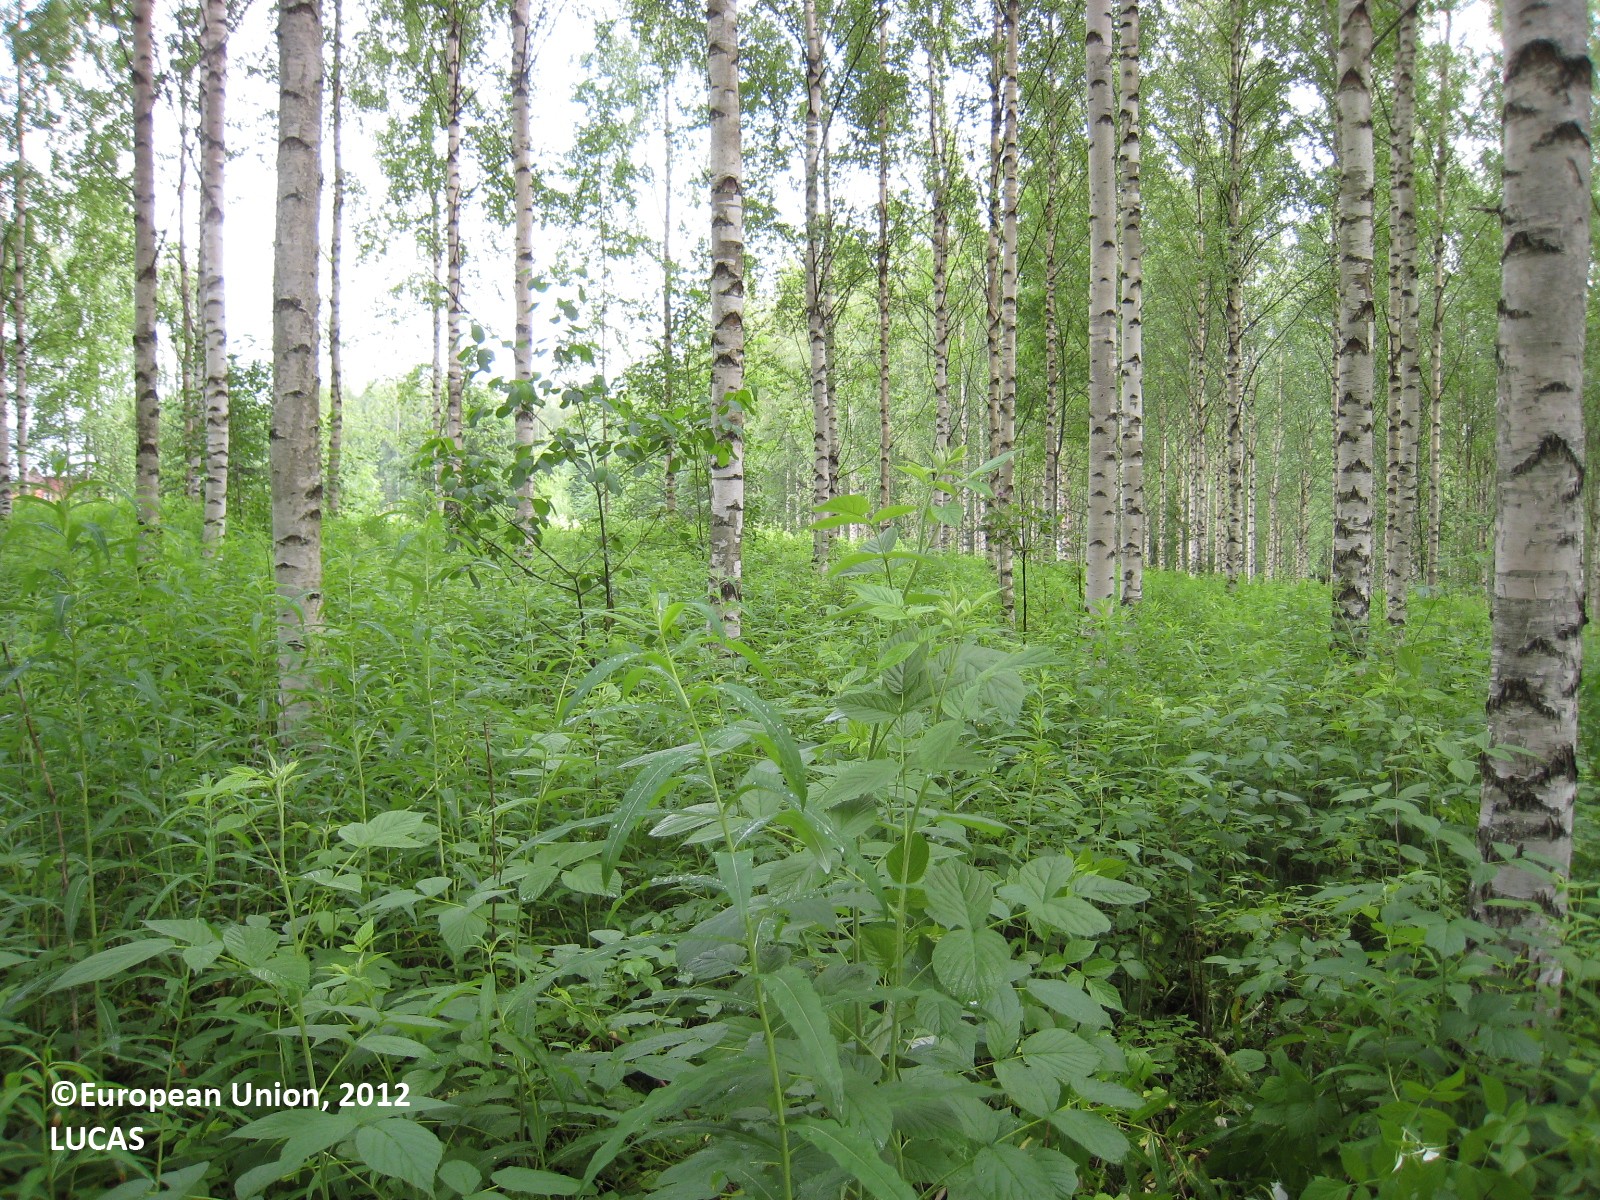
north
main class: Woodland
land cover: Broadleaved woodland
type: non-riverine alder, birch or aspen forest
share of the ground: > 75 %
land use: Forestry
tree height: > 5 m
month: July
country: FI
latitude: 61.8067
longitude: 26.9492
